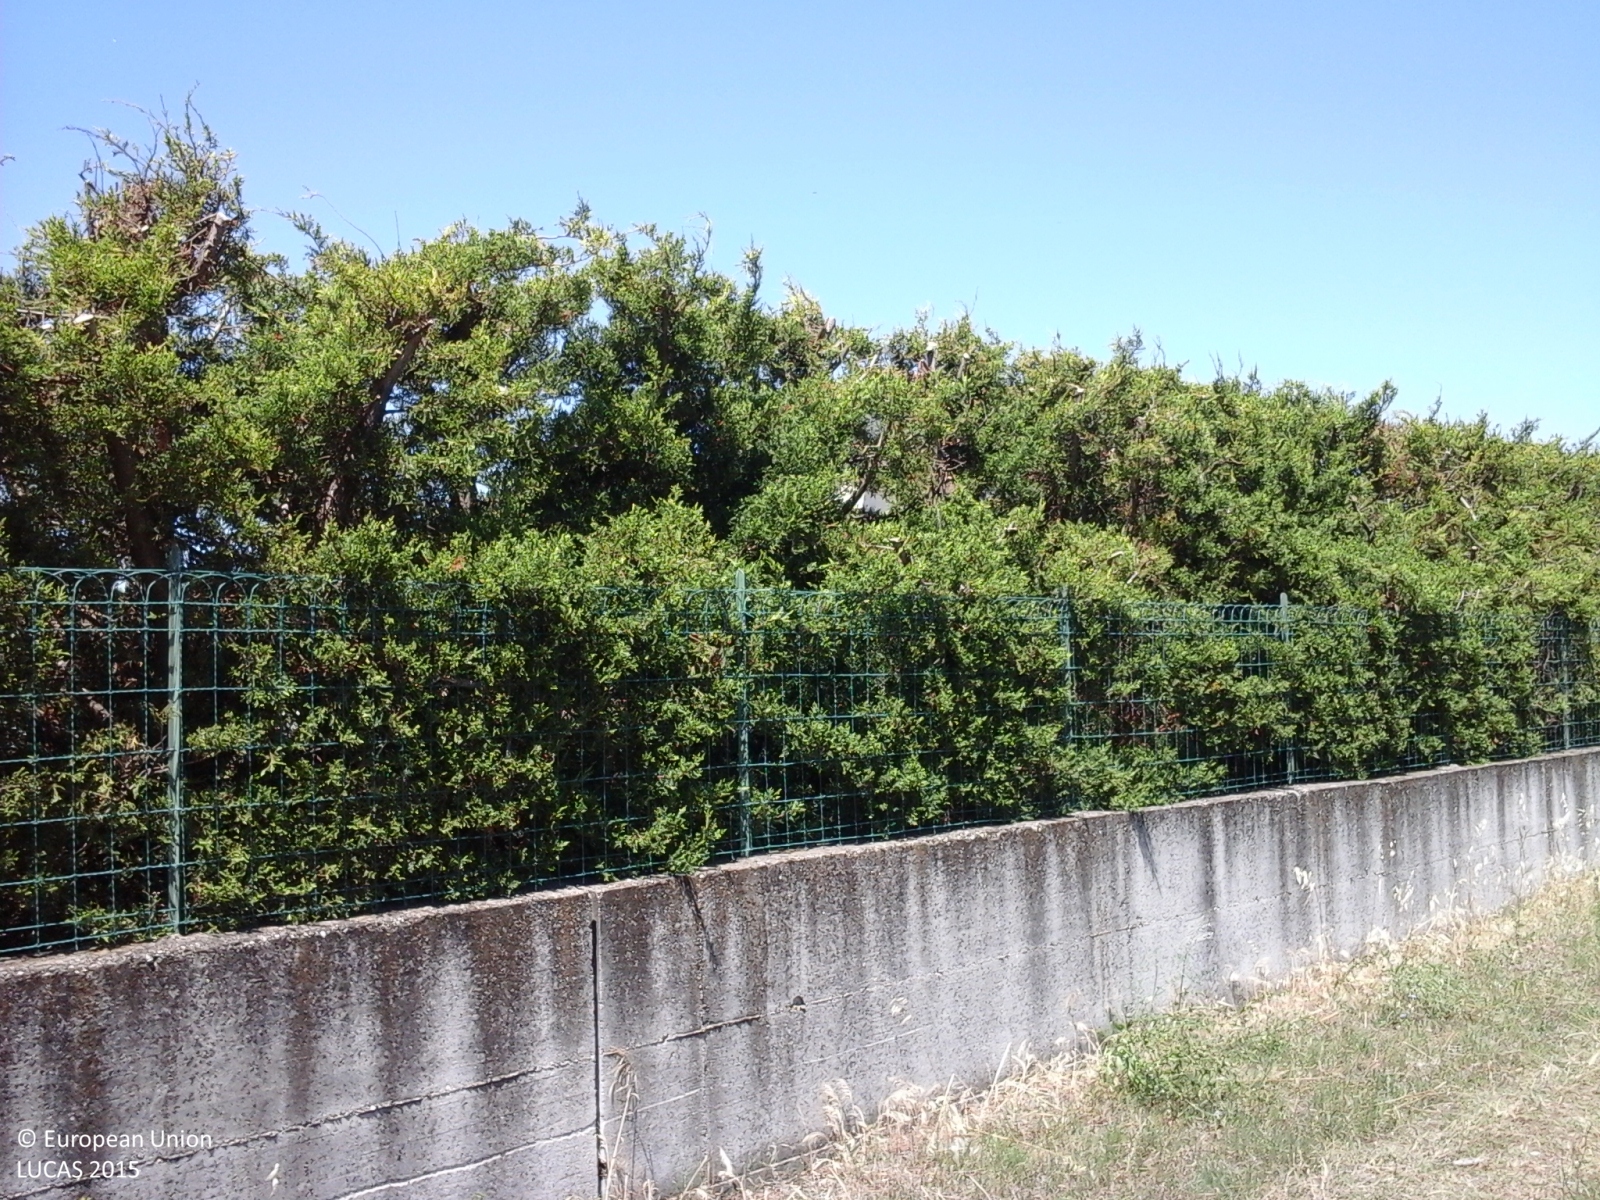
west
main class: Cropland
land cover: Other fresh vegetables
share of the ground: 50 - 75 %
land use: Agriculture (excluding fallow land and kitchen gardens)
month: June
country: IT
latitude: 40.4642
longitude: 15.0379
